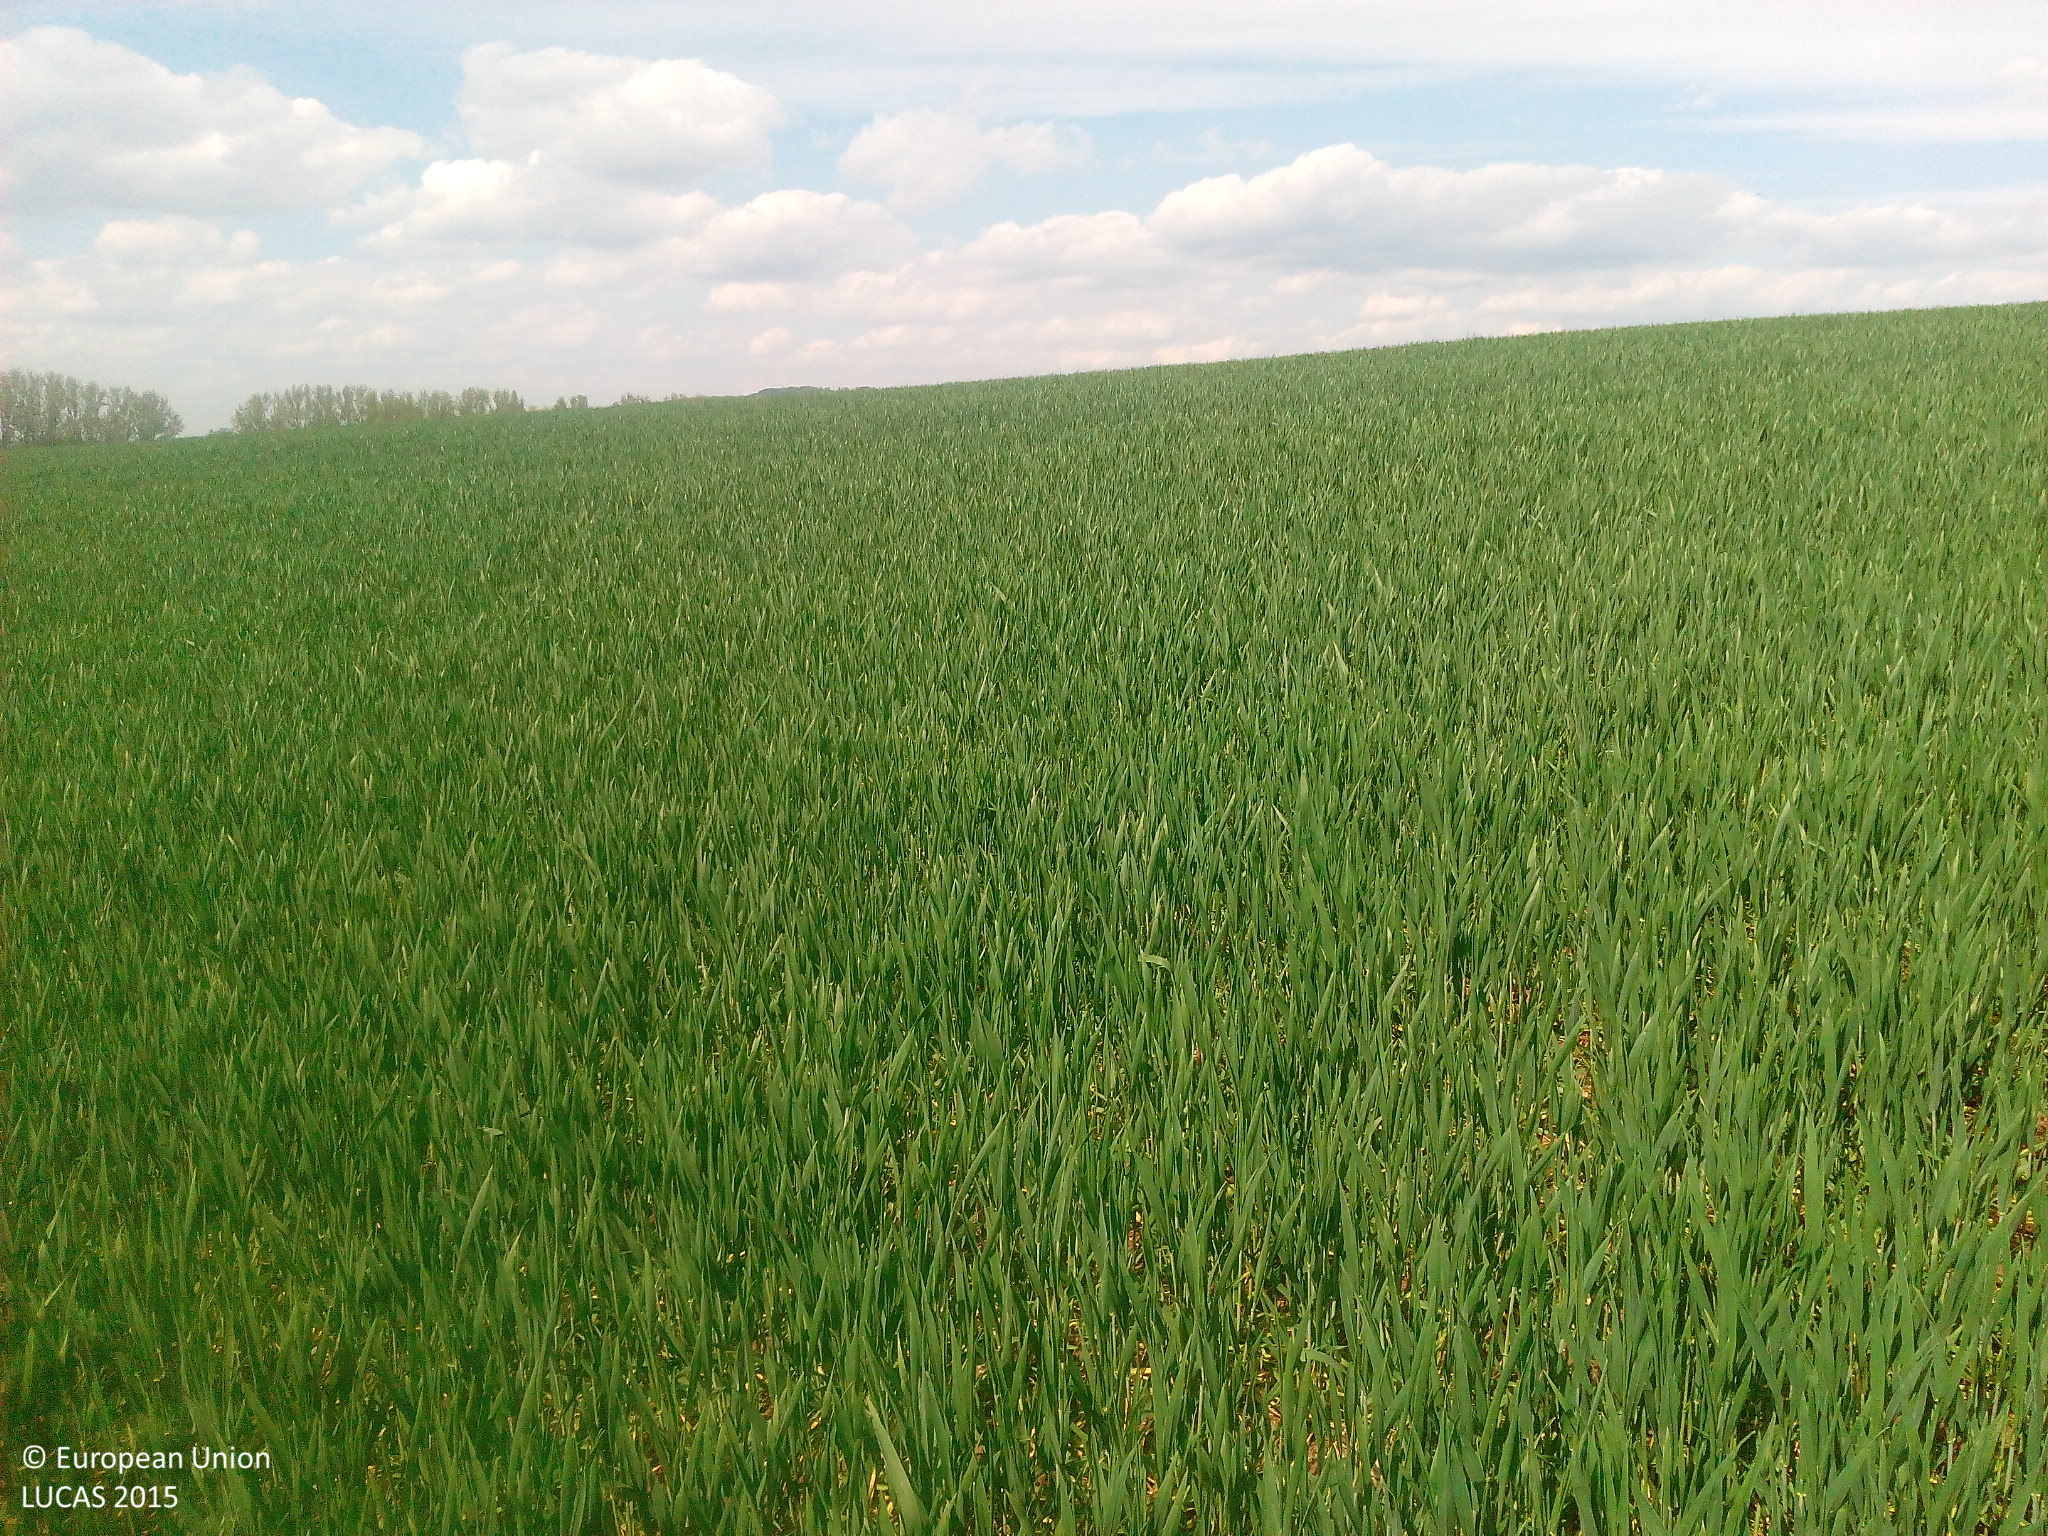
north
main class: Cropland
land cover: Triticale
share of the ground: > 75 %
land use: Agriculture (excluding fallow land and kitchen gardens)
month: May
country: DE
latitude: 51.3708
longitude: 9.9569
